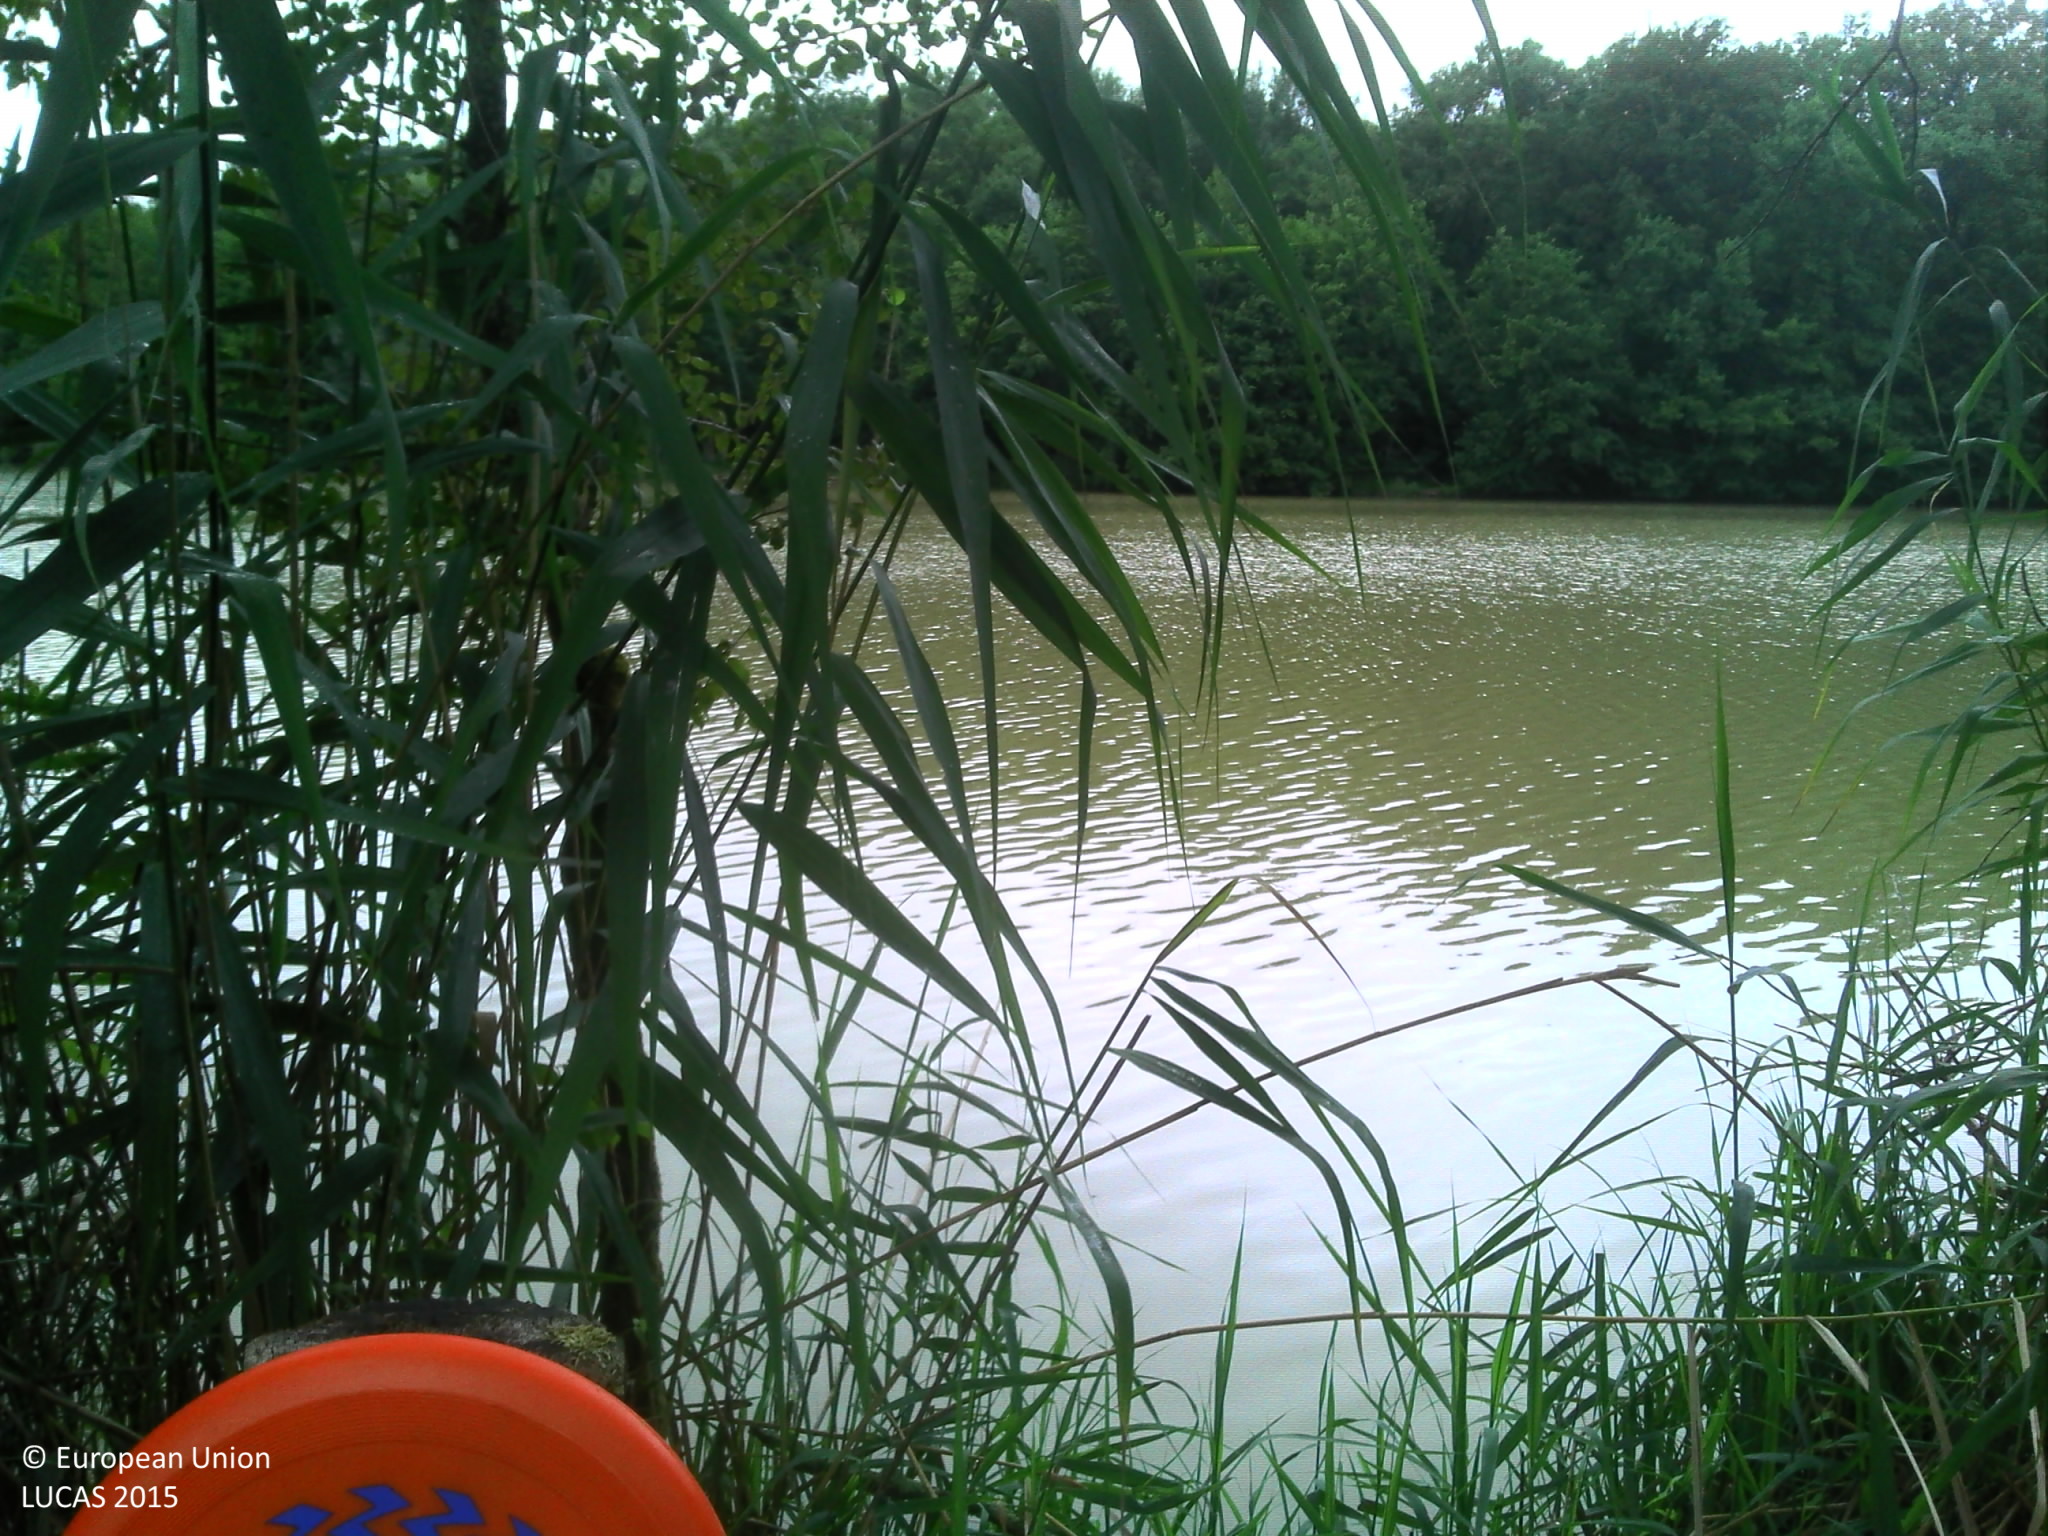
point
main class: Grassland
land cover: Grassland without tree/shrub cover
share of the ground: > 75 %
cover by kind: herbaceous plants 100 %
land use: Agriculture (excluding fallow land and kitchen gardens)
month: July
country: FR
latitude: 46.6372
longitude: 5.1294
